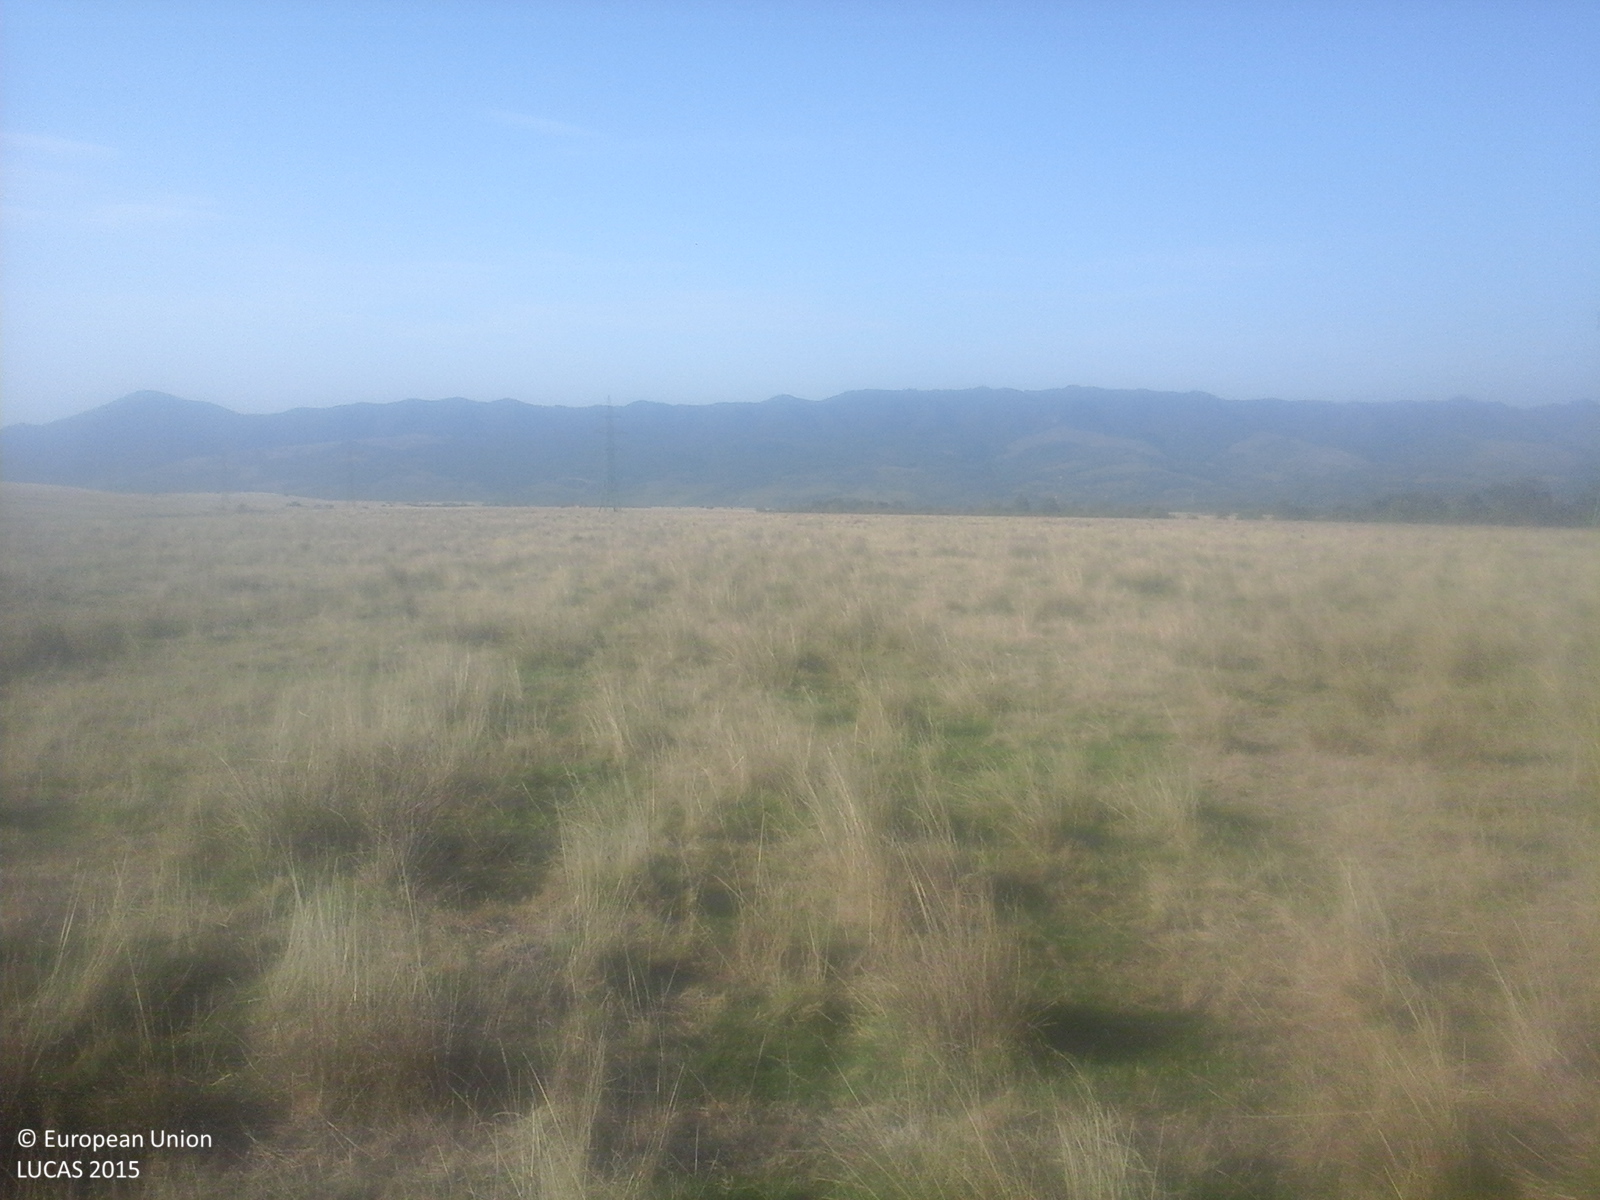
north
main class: Grassland
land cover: Grassland without tree/shrub cover
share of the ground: > 75 %
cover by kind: herbaceous plants 100 %
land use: Agriculture (excluding fallow land and kitchen gardens)
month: September
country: RO
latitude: 45.4909
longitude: 23.0669
